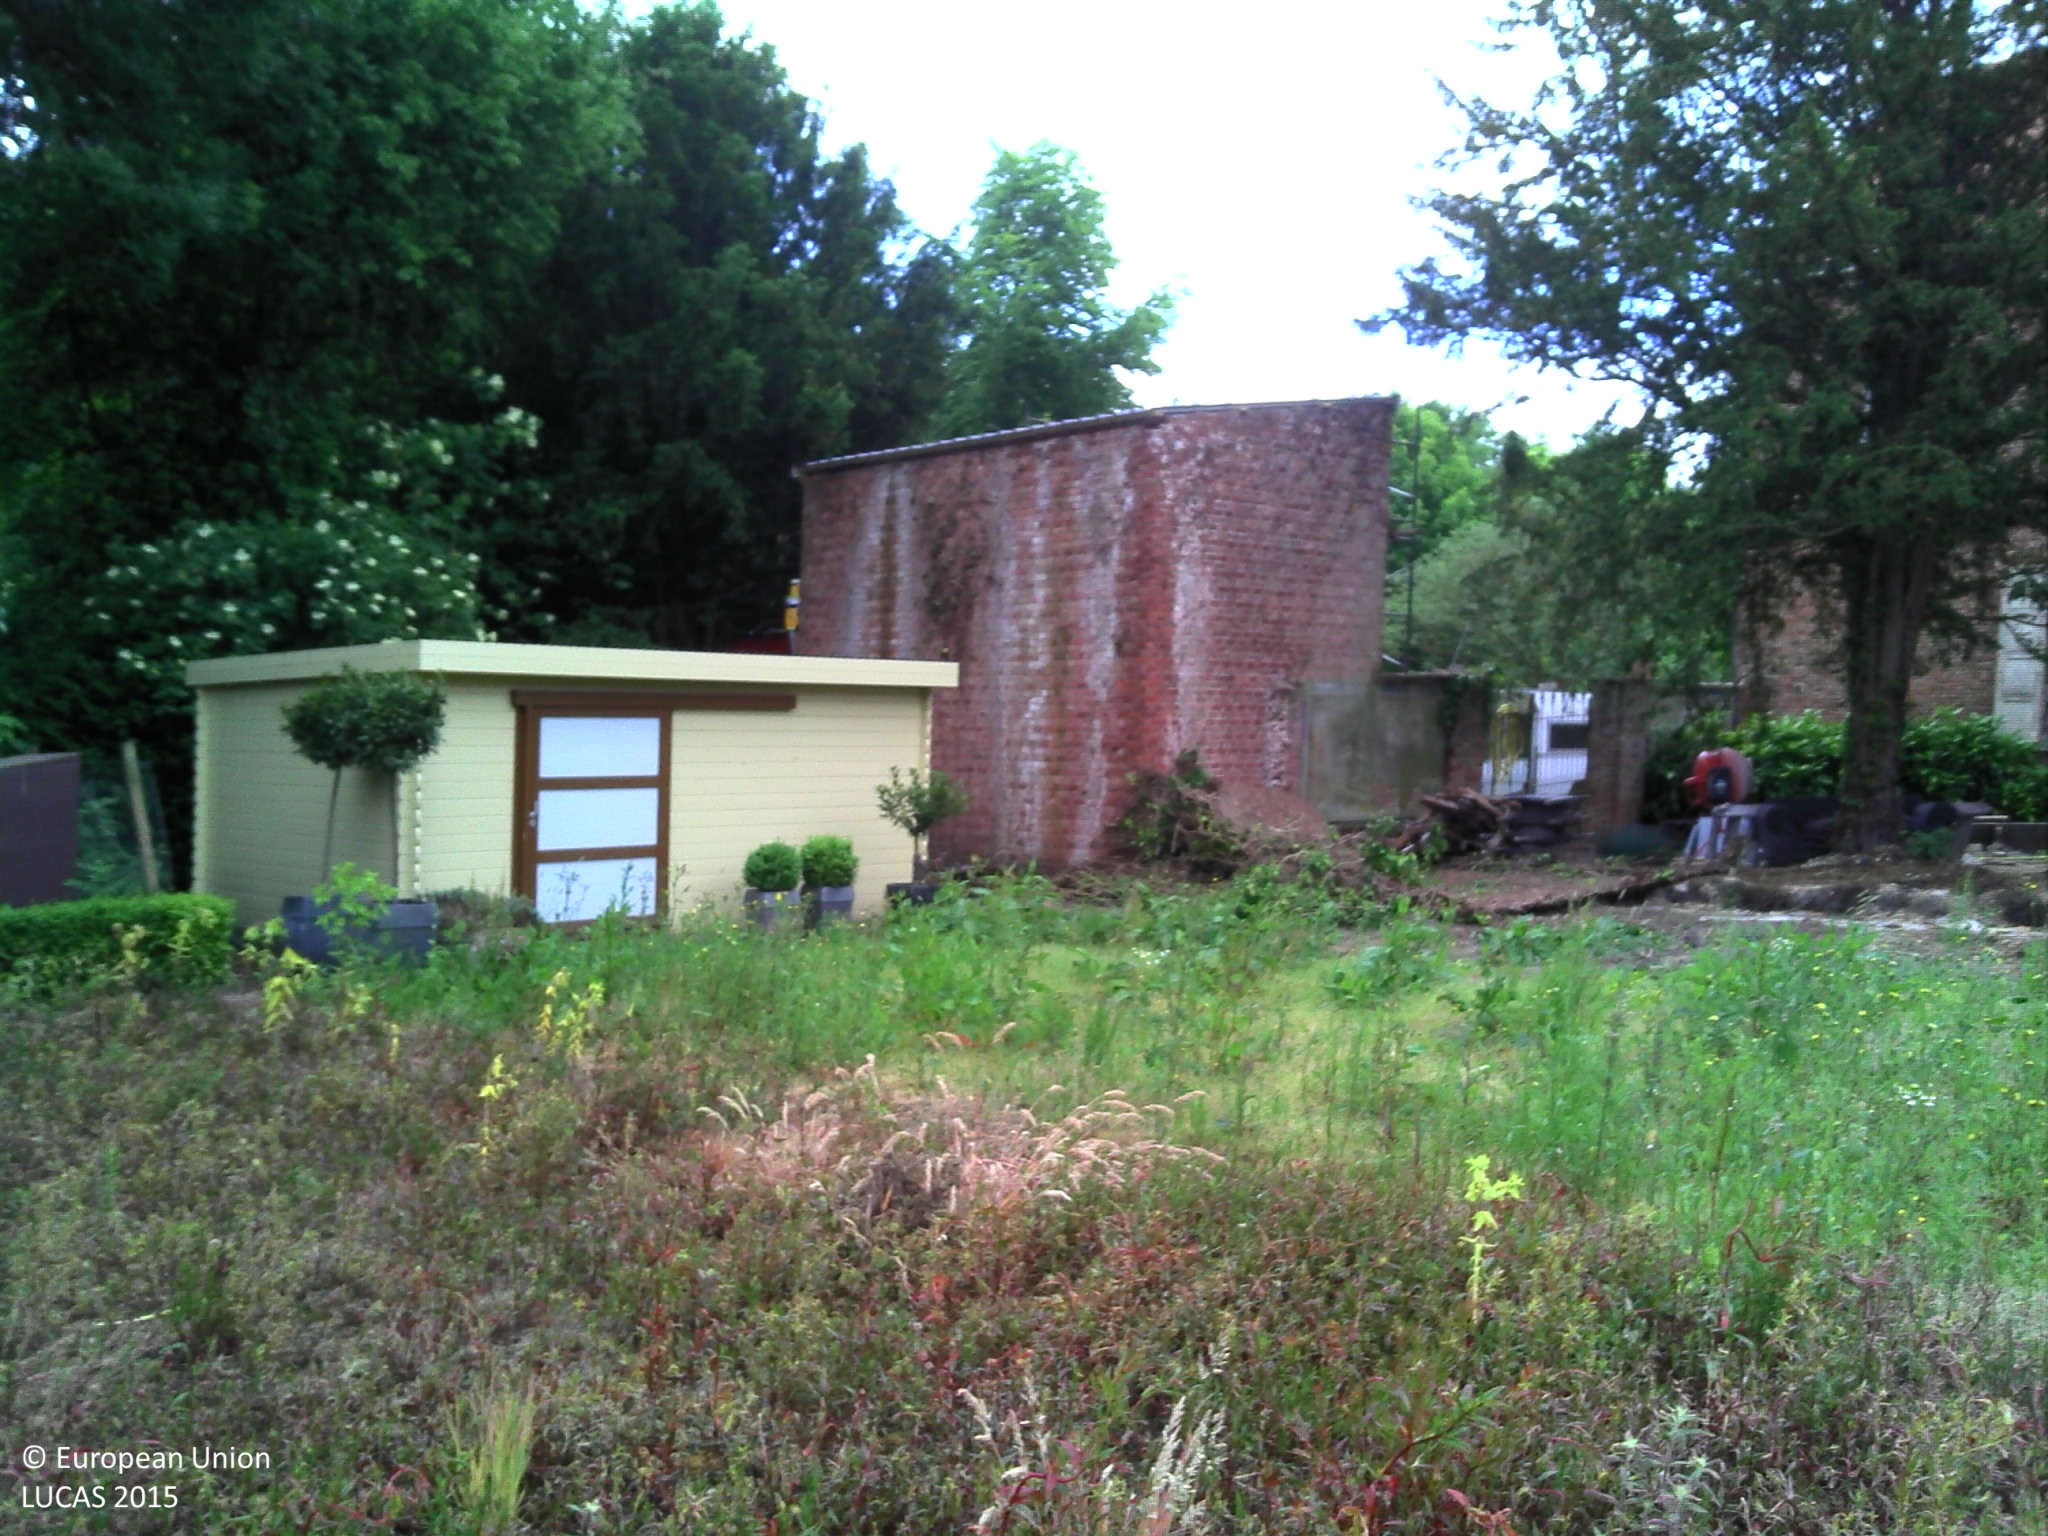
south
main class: Grassland
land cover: Spontaneously vegetated surfaces
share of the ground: > 75 %
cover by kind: herbaceous plants 70 %, lichens and mosses 30 %
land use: Residential
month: June
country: BE
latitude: 50.9847
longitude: 4.0542
